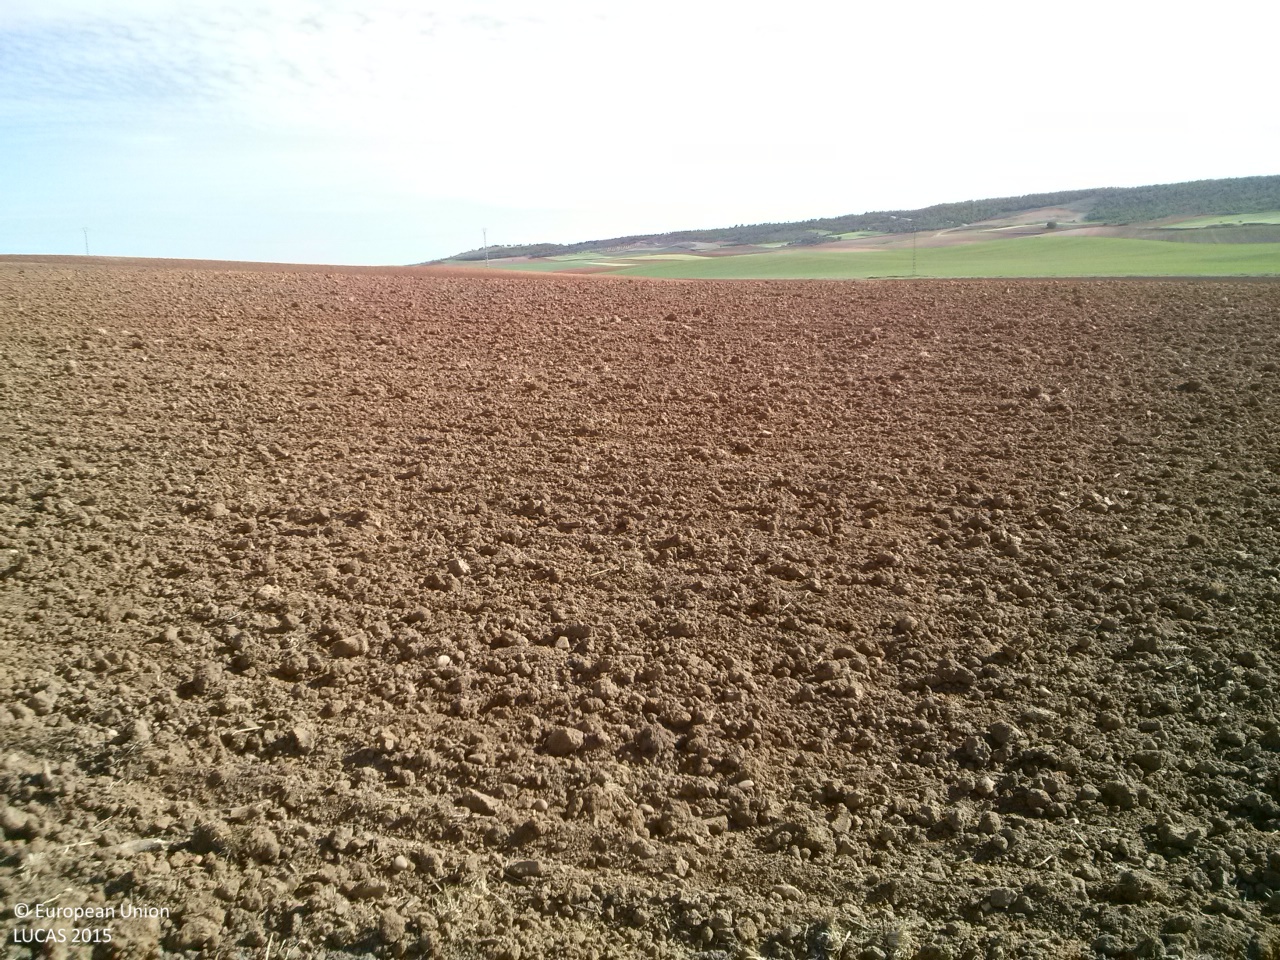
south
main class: Cropland
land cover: Sunflower
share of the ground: < 10 %
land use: Agriculture (excluding fallow land and kitchen gardens)
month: May
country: ES
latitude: 39.8528
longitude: -2.7475
